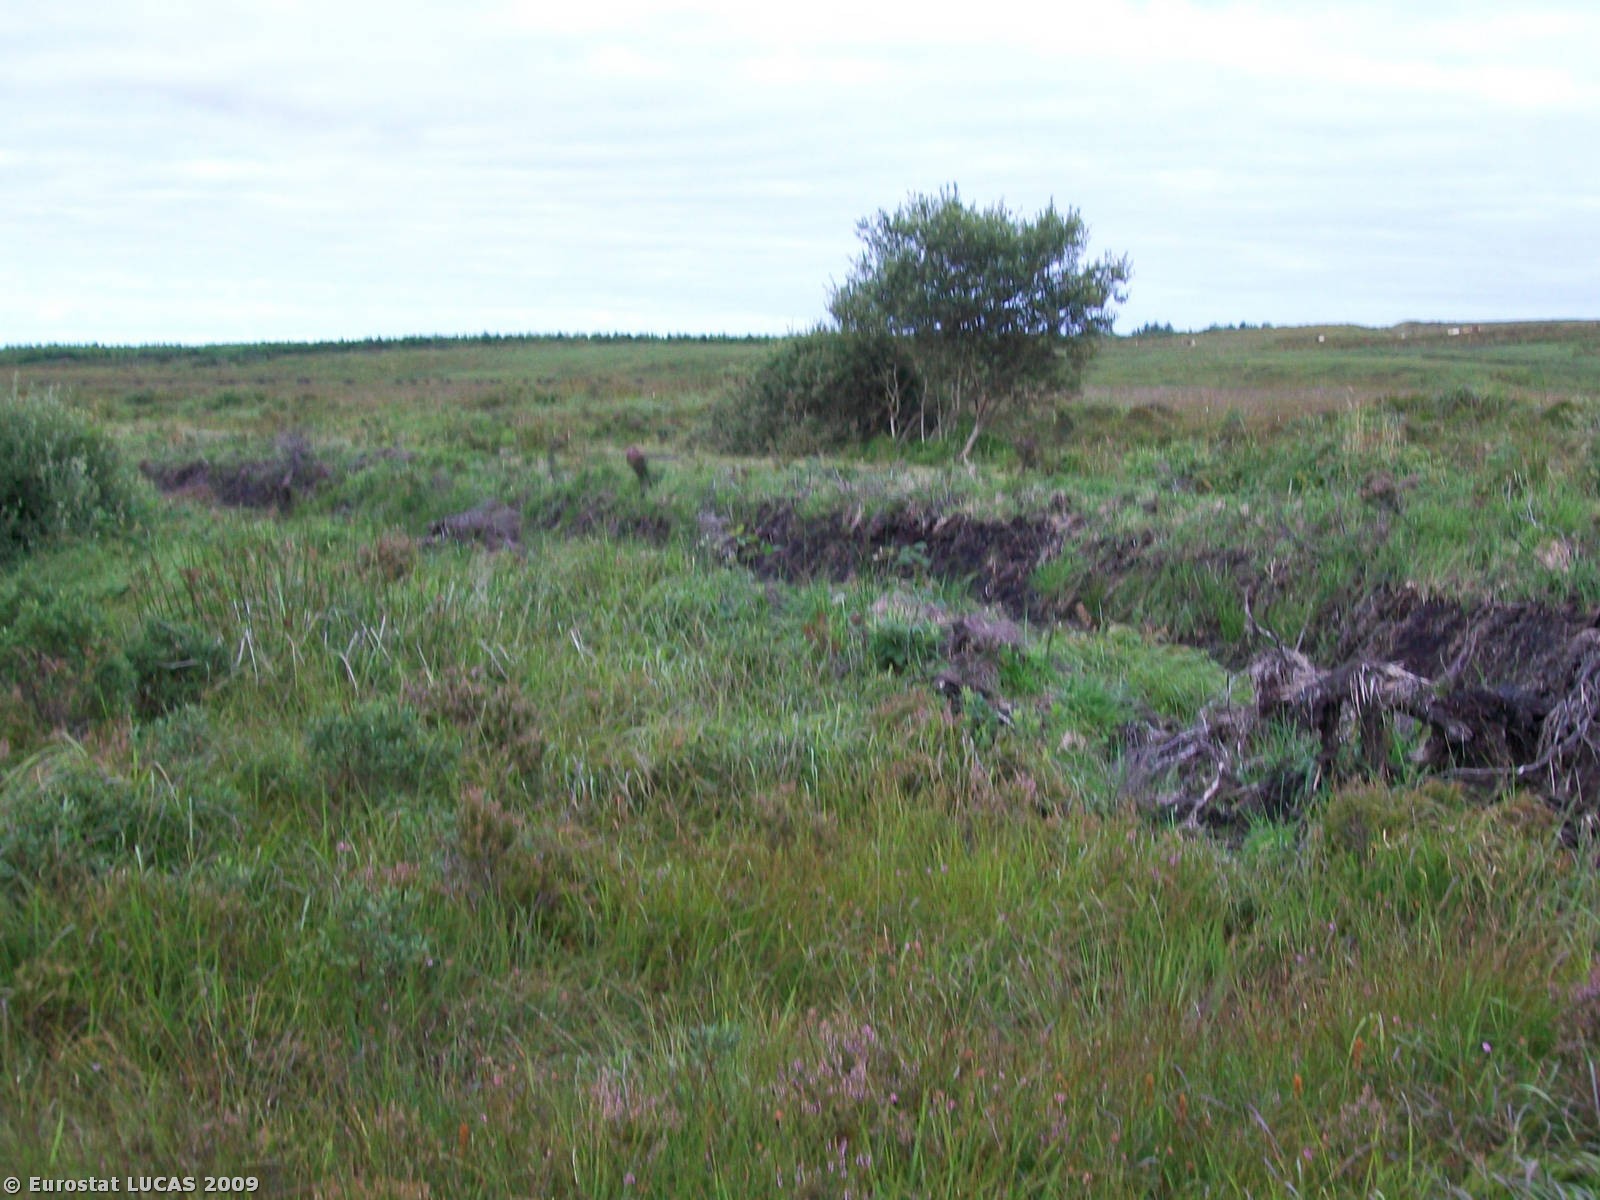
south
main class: Wetlands
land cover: Peatbogs
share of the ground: > 75 %
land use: Mining and quarrying
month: August
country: IE
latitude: 52.7554
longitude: -9.1705
